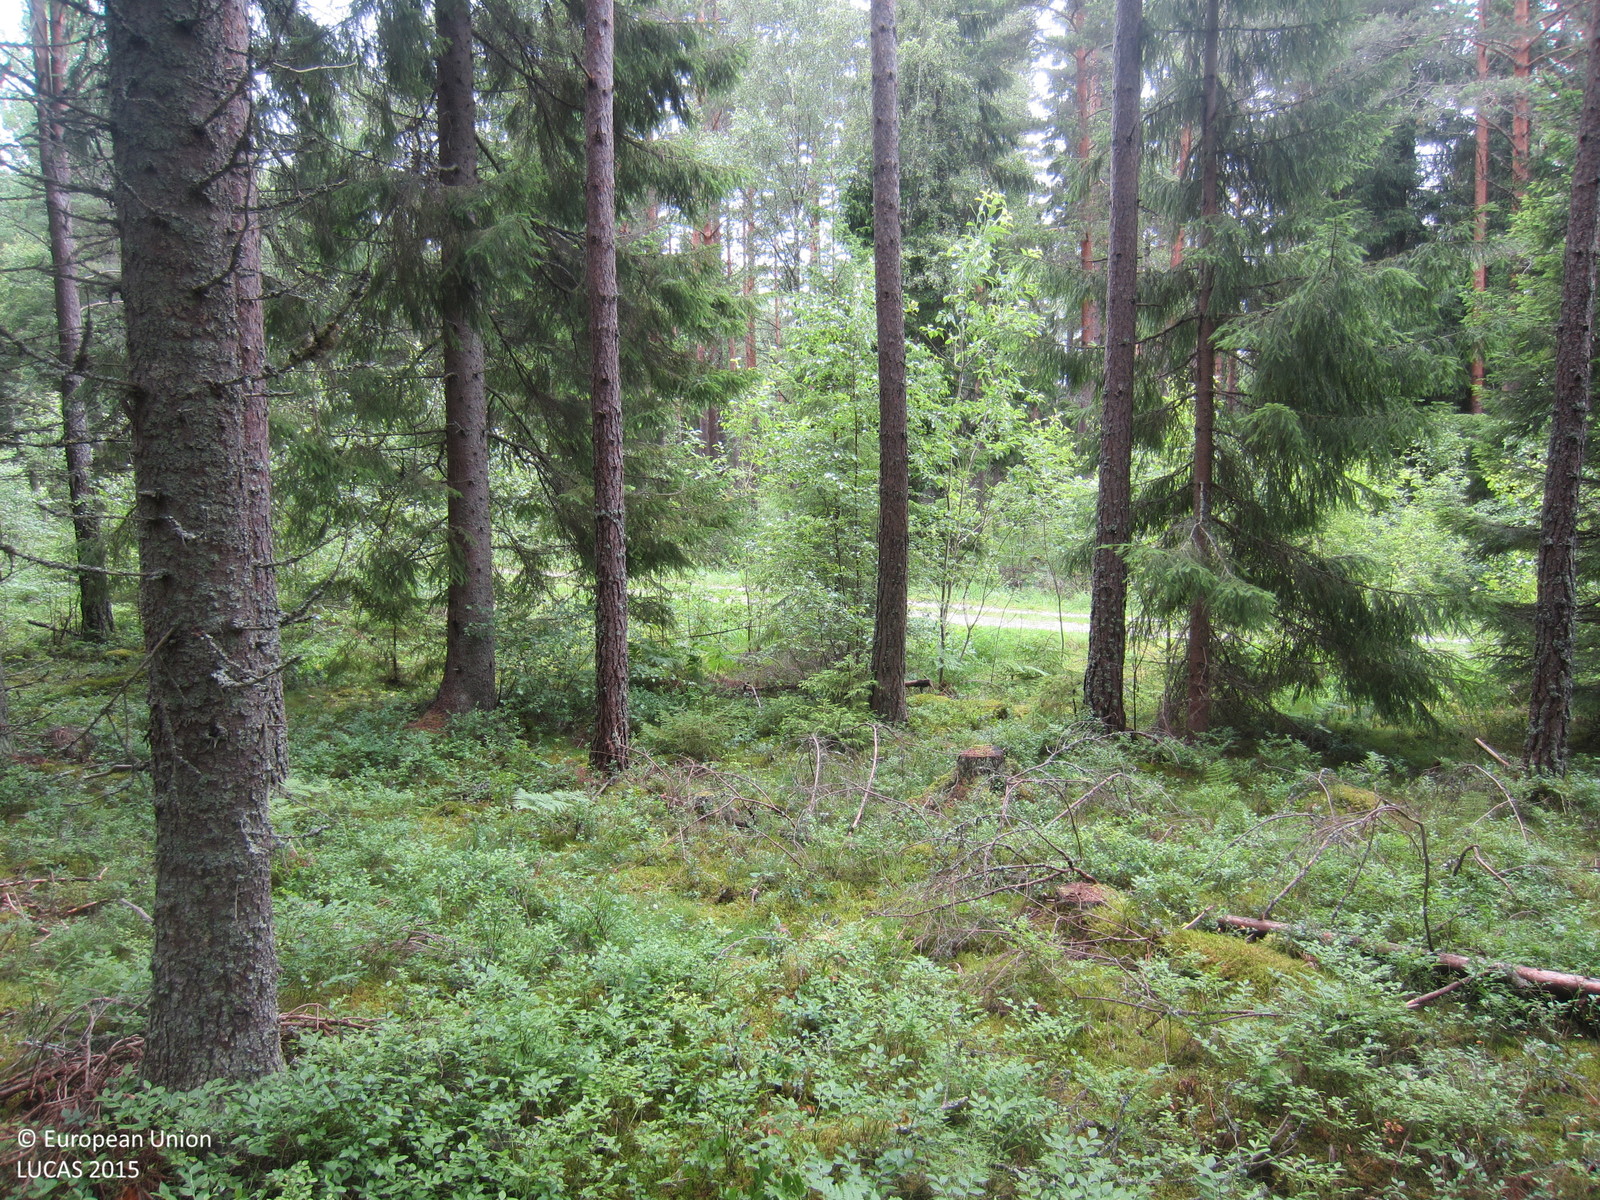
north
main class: Woodland
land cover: Spruce dominated coniferous woodland
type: boreal forest
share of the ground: > 75 %
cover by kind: coniferous forest trees 70 %, herbaceous plants 10 %, lichens and mosses 10 %, broadleaved forest trees 5 %, shrubs 5 %
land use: Forestry
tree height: > 5 m
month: July
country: SE
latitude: 59.8241
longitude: 17.0376
